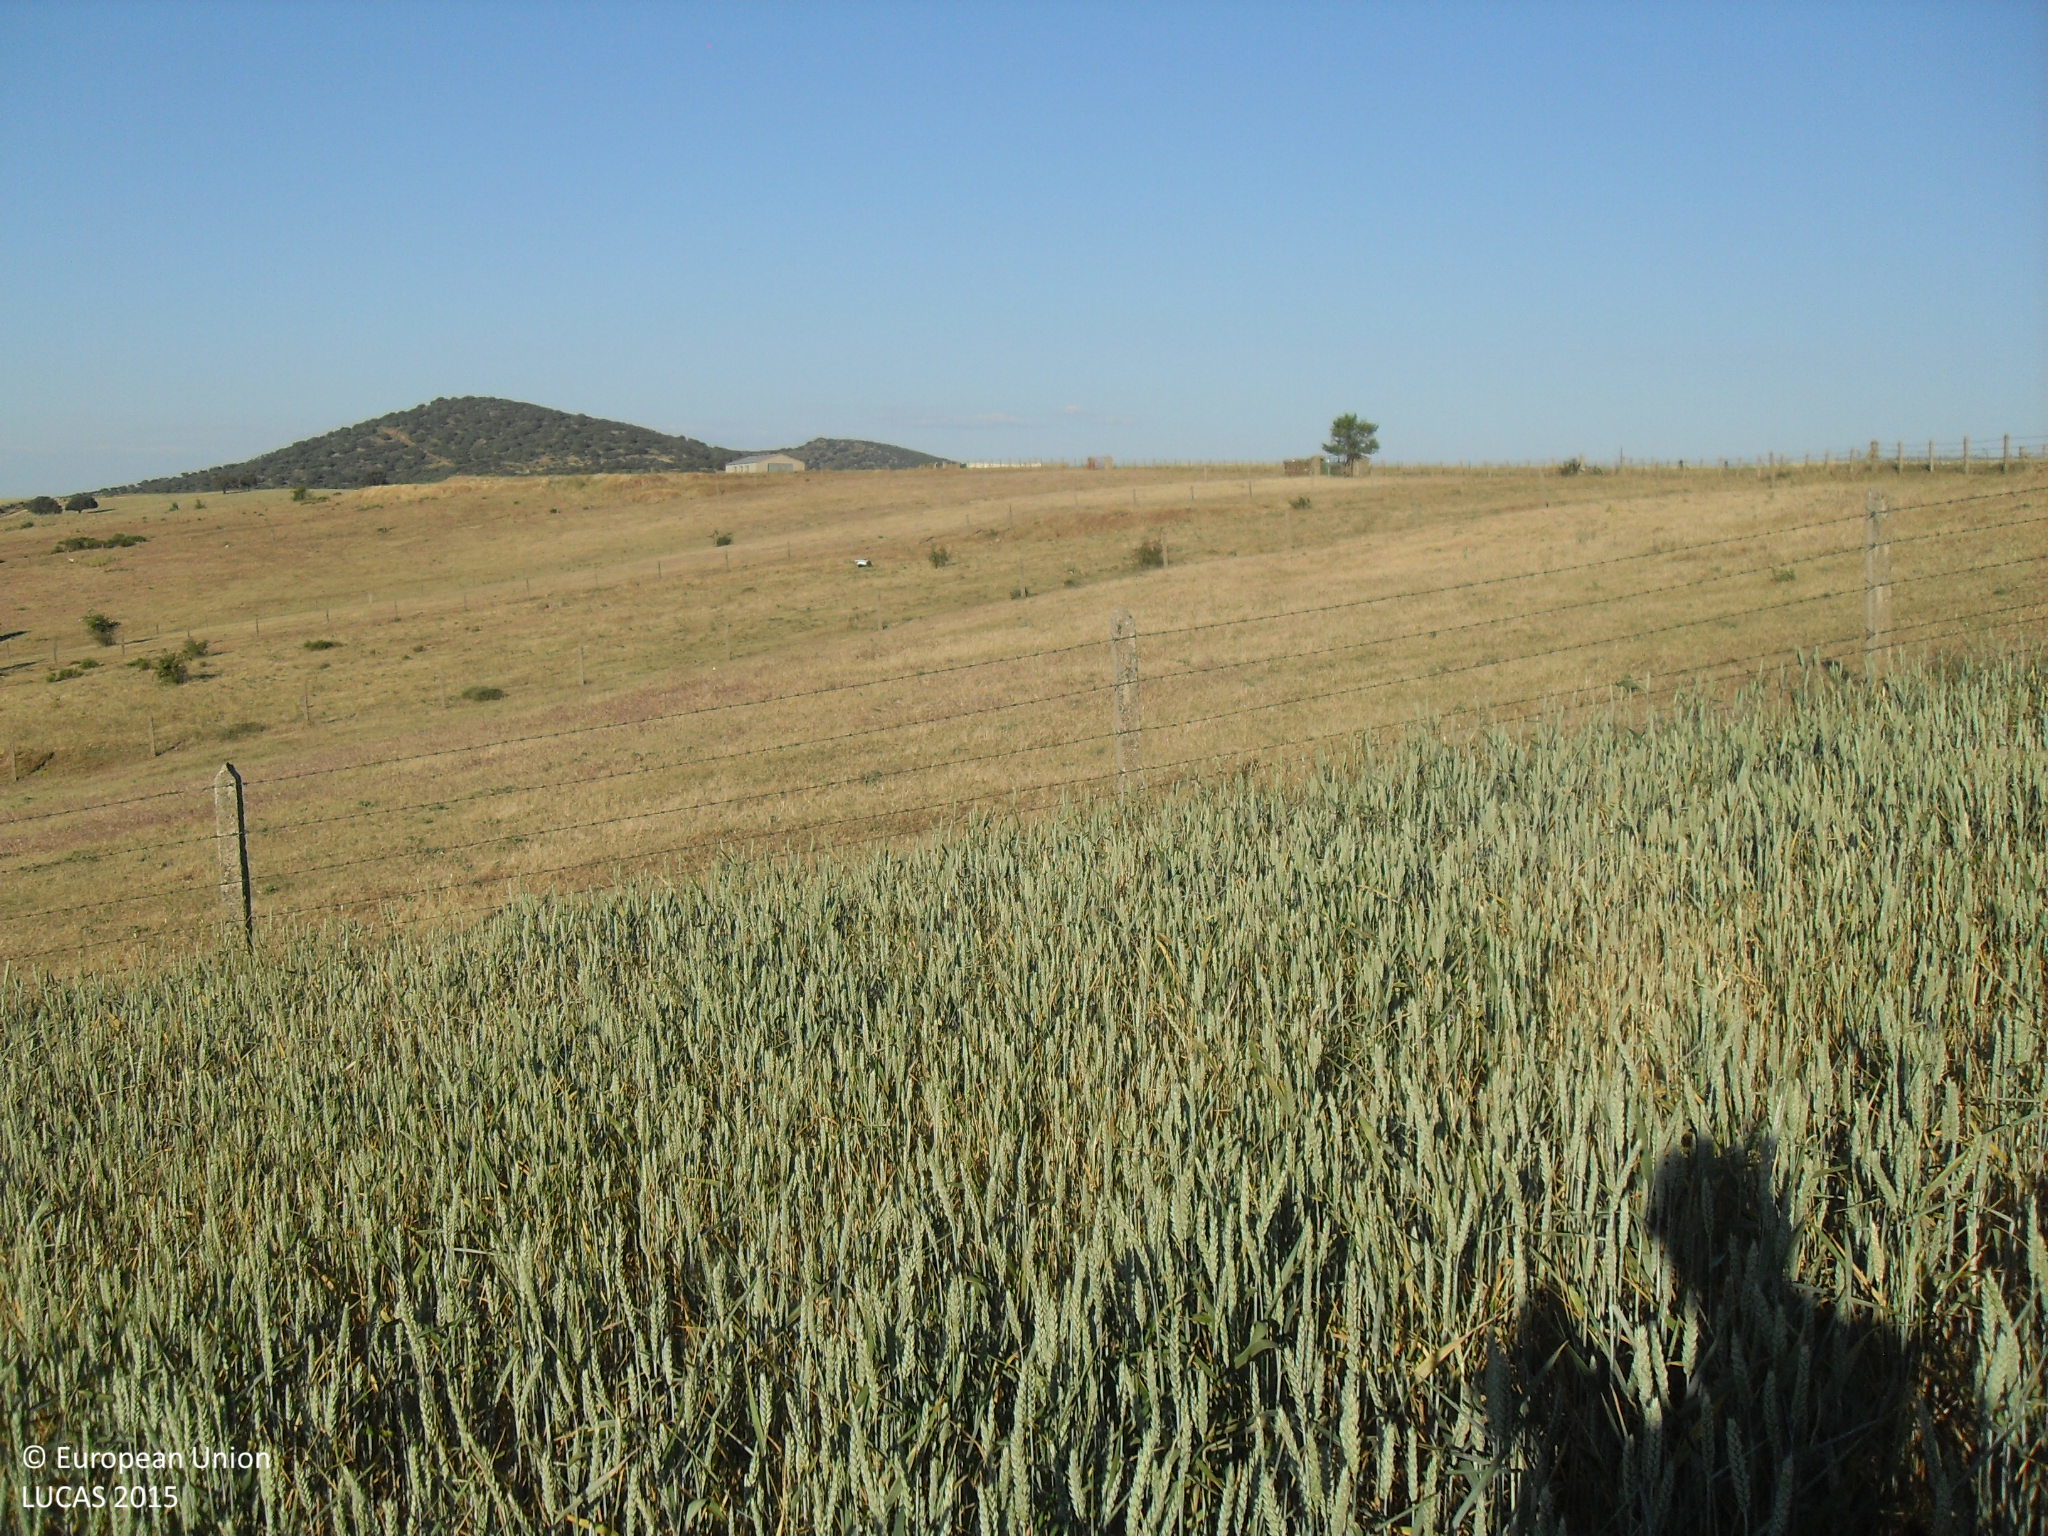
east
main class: Cropland
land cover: Common wheat
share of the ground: > 75 %
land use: Agriculture (excluding fallow land and kitchen gardens)
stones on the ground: < 10 %
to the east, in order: Common wheat; Fences; Grassland without tree/shrub cover; Fences; Grassland without tree/shrub cover; Fences; Grassland without tree/shrub cover; Fences; Grassland without tree/shrub cover; Fences; Grassland without tree/shrub cover; Dry stone walls; Grass margins; Tracks
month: June
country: ES
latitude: 40.5411
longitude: -5.5718
